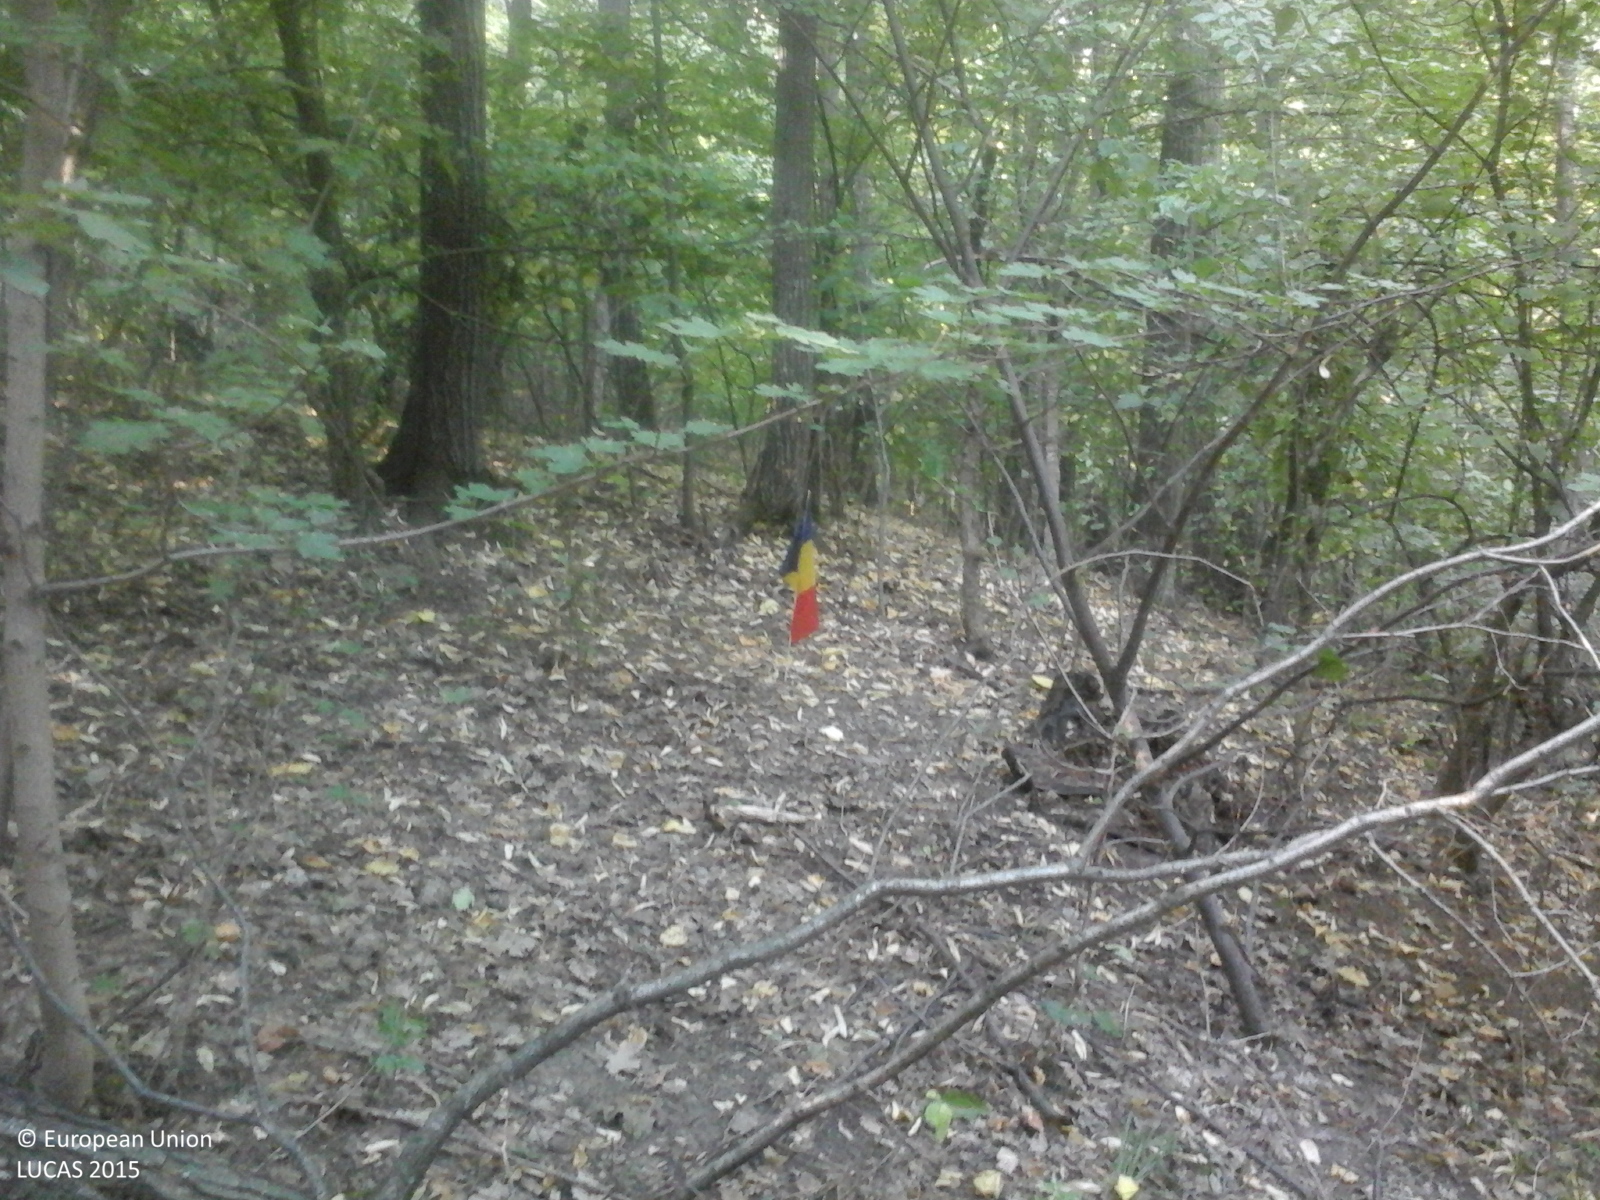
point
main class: Woodland
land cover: Broadleaved woodland
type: mesophytic deciduous forest
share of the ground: > 75 %
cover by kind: broadleaved forest trees 100 %
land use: Forestry
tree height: > 5 m
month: July
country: RO
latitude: 46.2918
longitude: 27.8384
